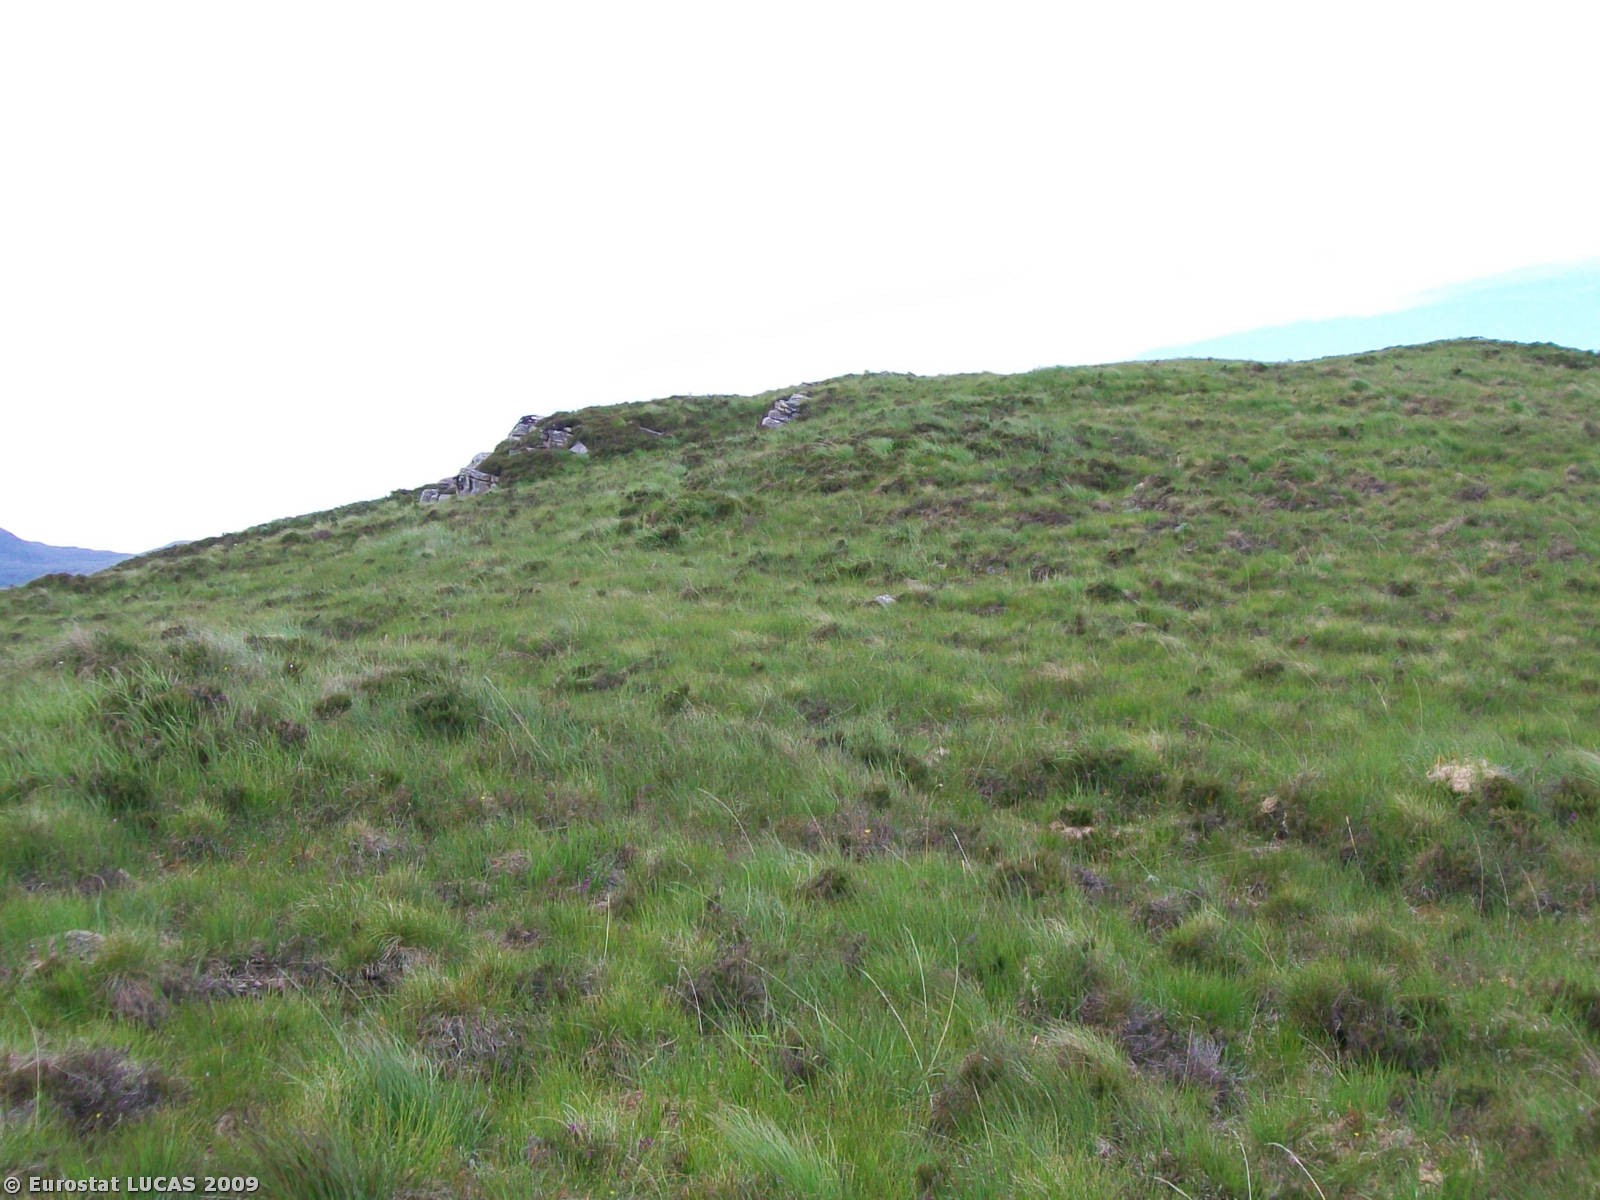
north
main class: Shrubland
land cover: Shrubland without tree cover
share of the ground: > 75 %
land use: Unused
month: June
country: GB
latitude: 58.0041
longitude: -5.0767
